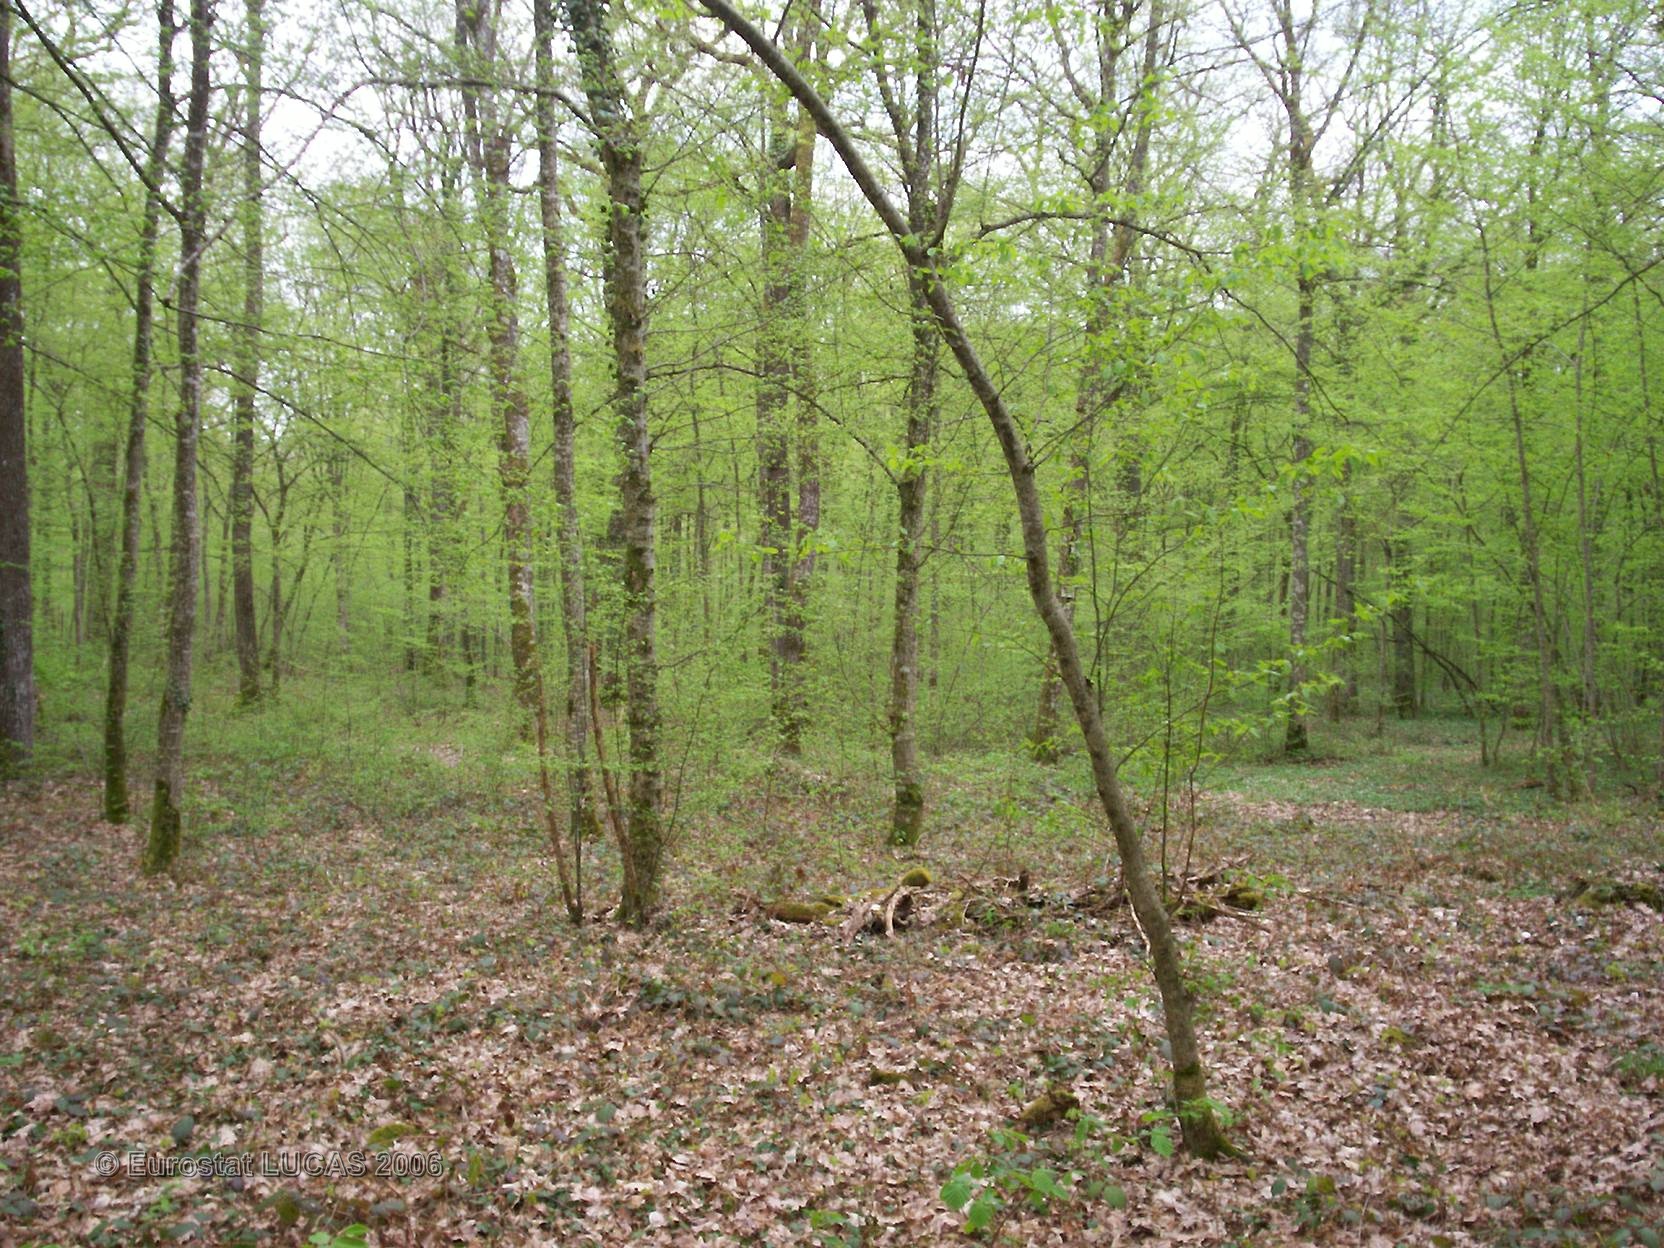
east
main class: Woodland
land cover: Broadleaved forest
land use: Forestry
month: April
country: FR
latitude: 48.3309
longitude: 5.9940
